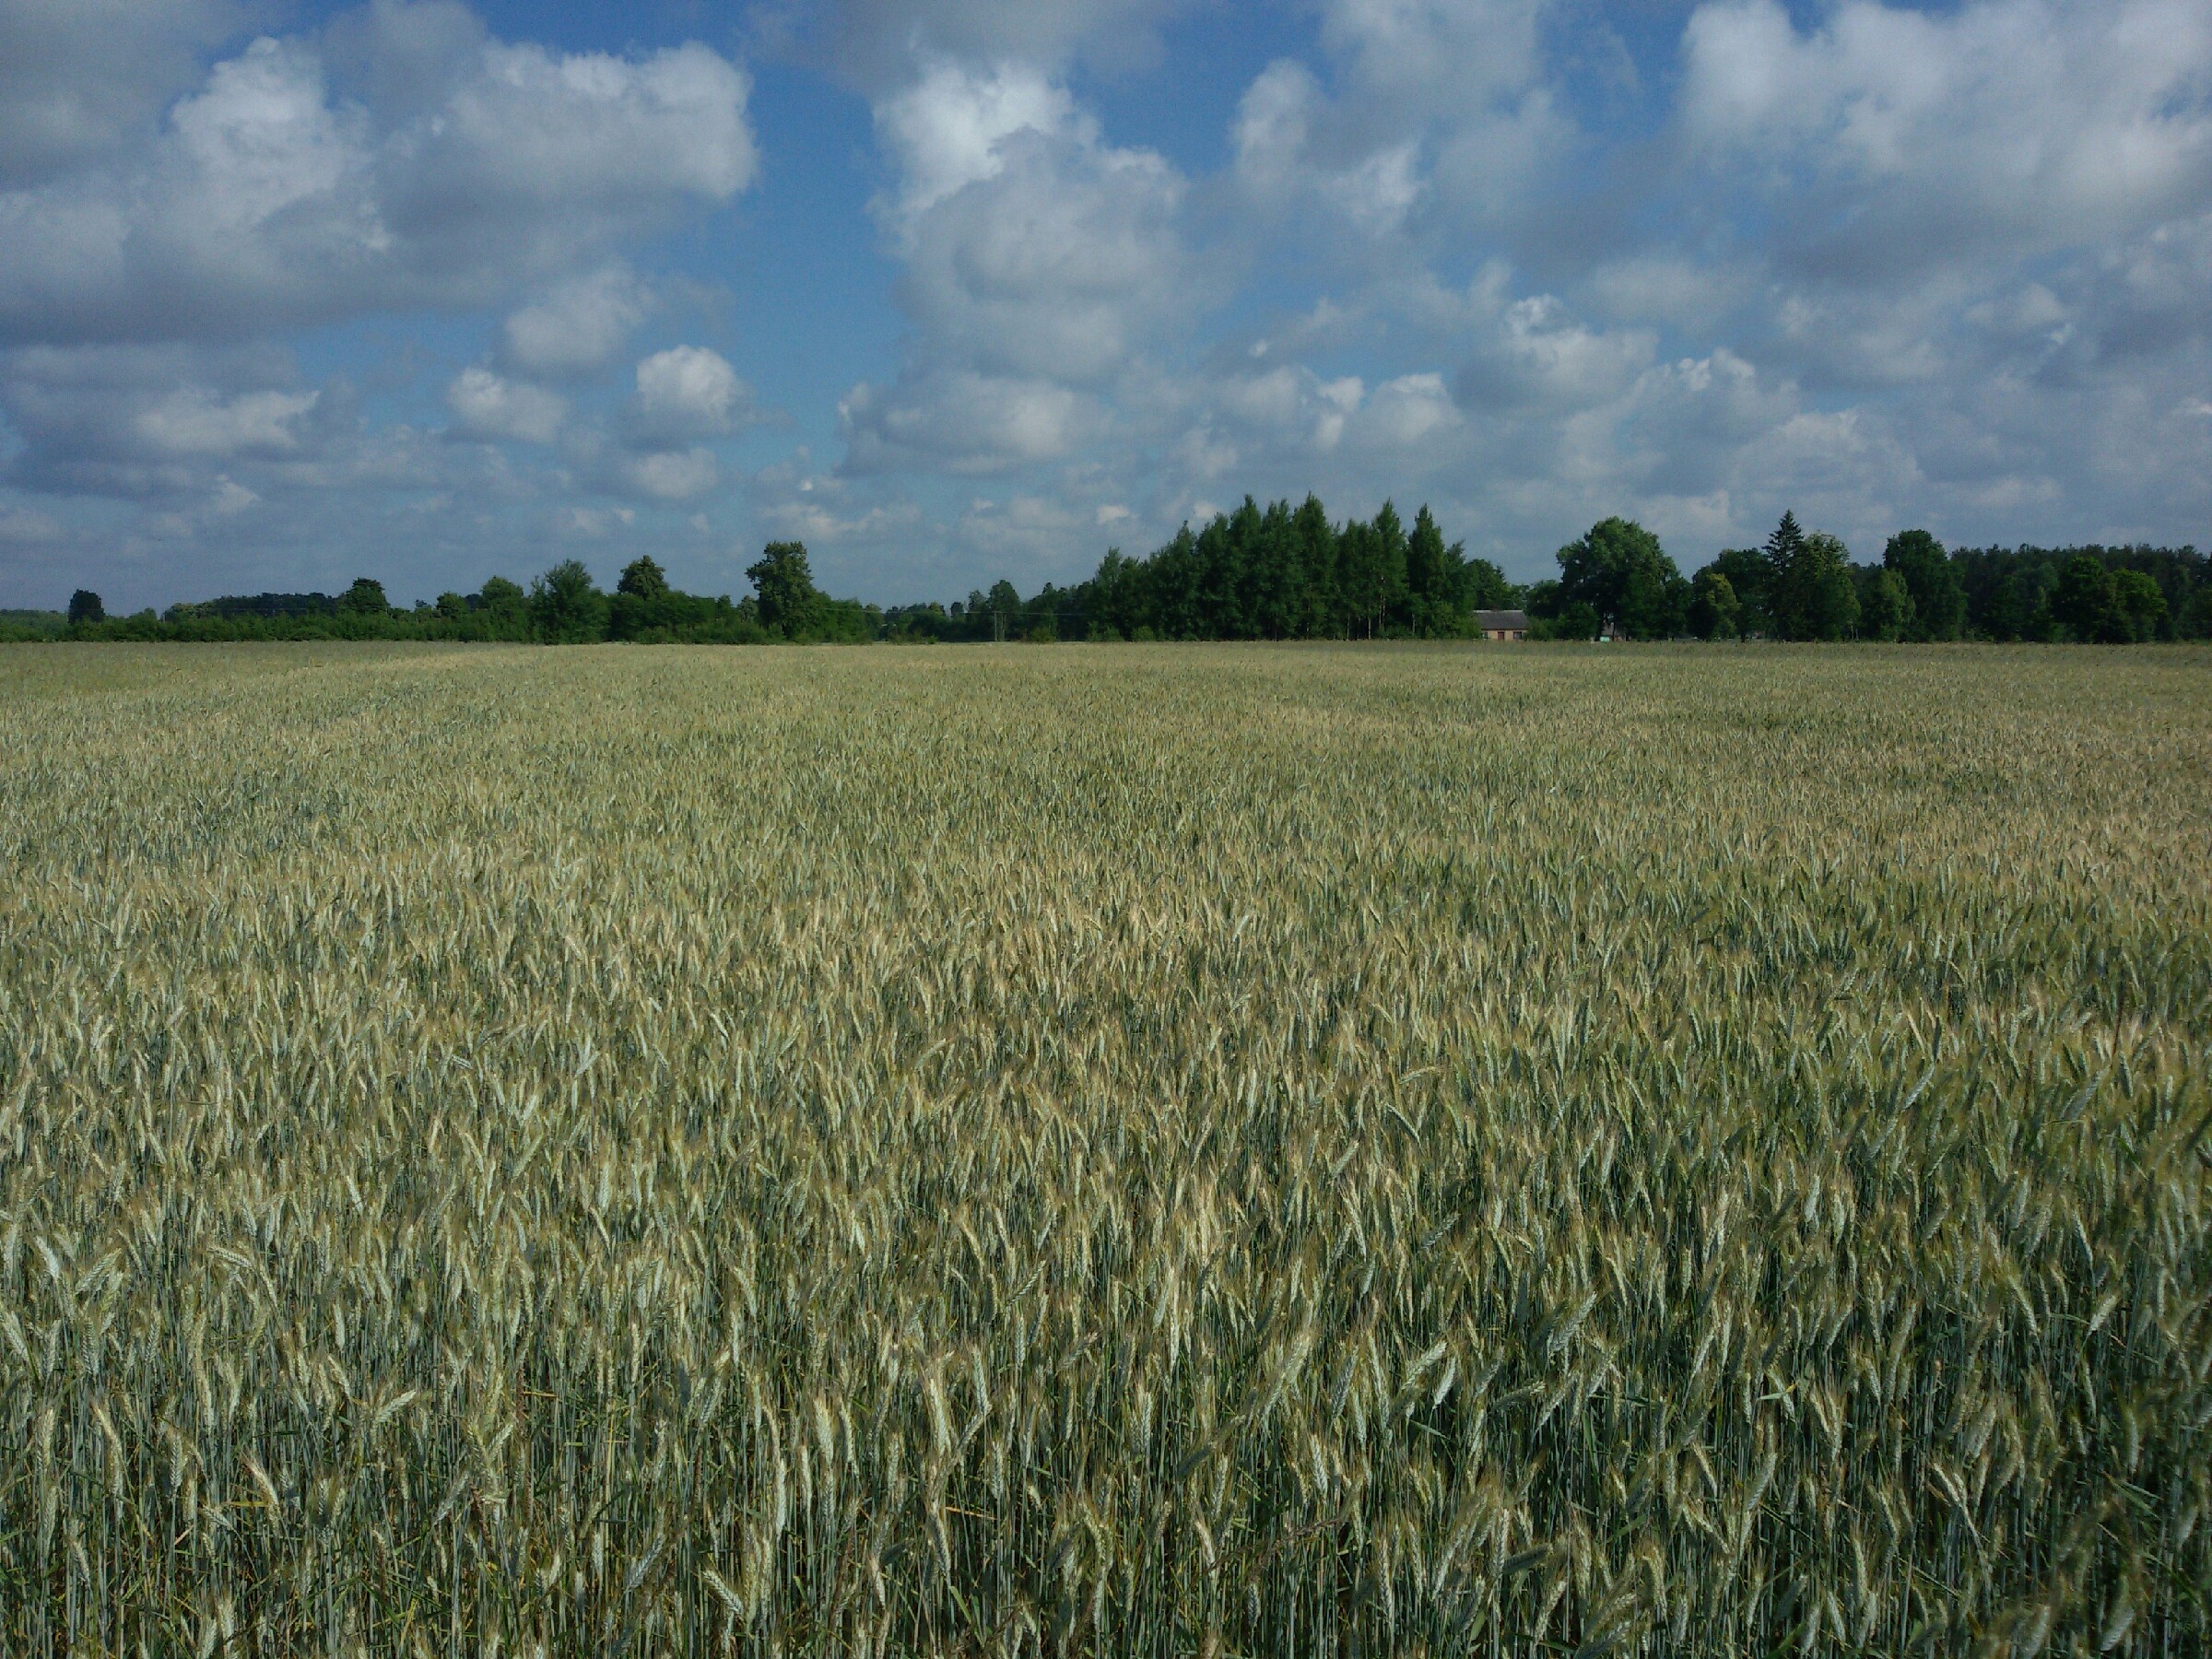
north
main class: Cropland
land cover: Rye
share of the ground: > 75 %
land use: Agriculture (excluding fallow land and kitchen gardens)
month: June
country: PL
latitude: 51.9219
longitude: 23.0905
